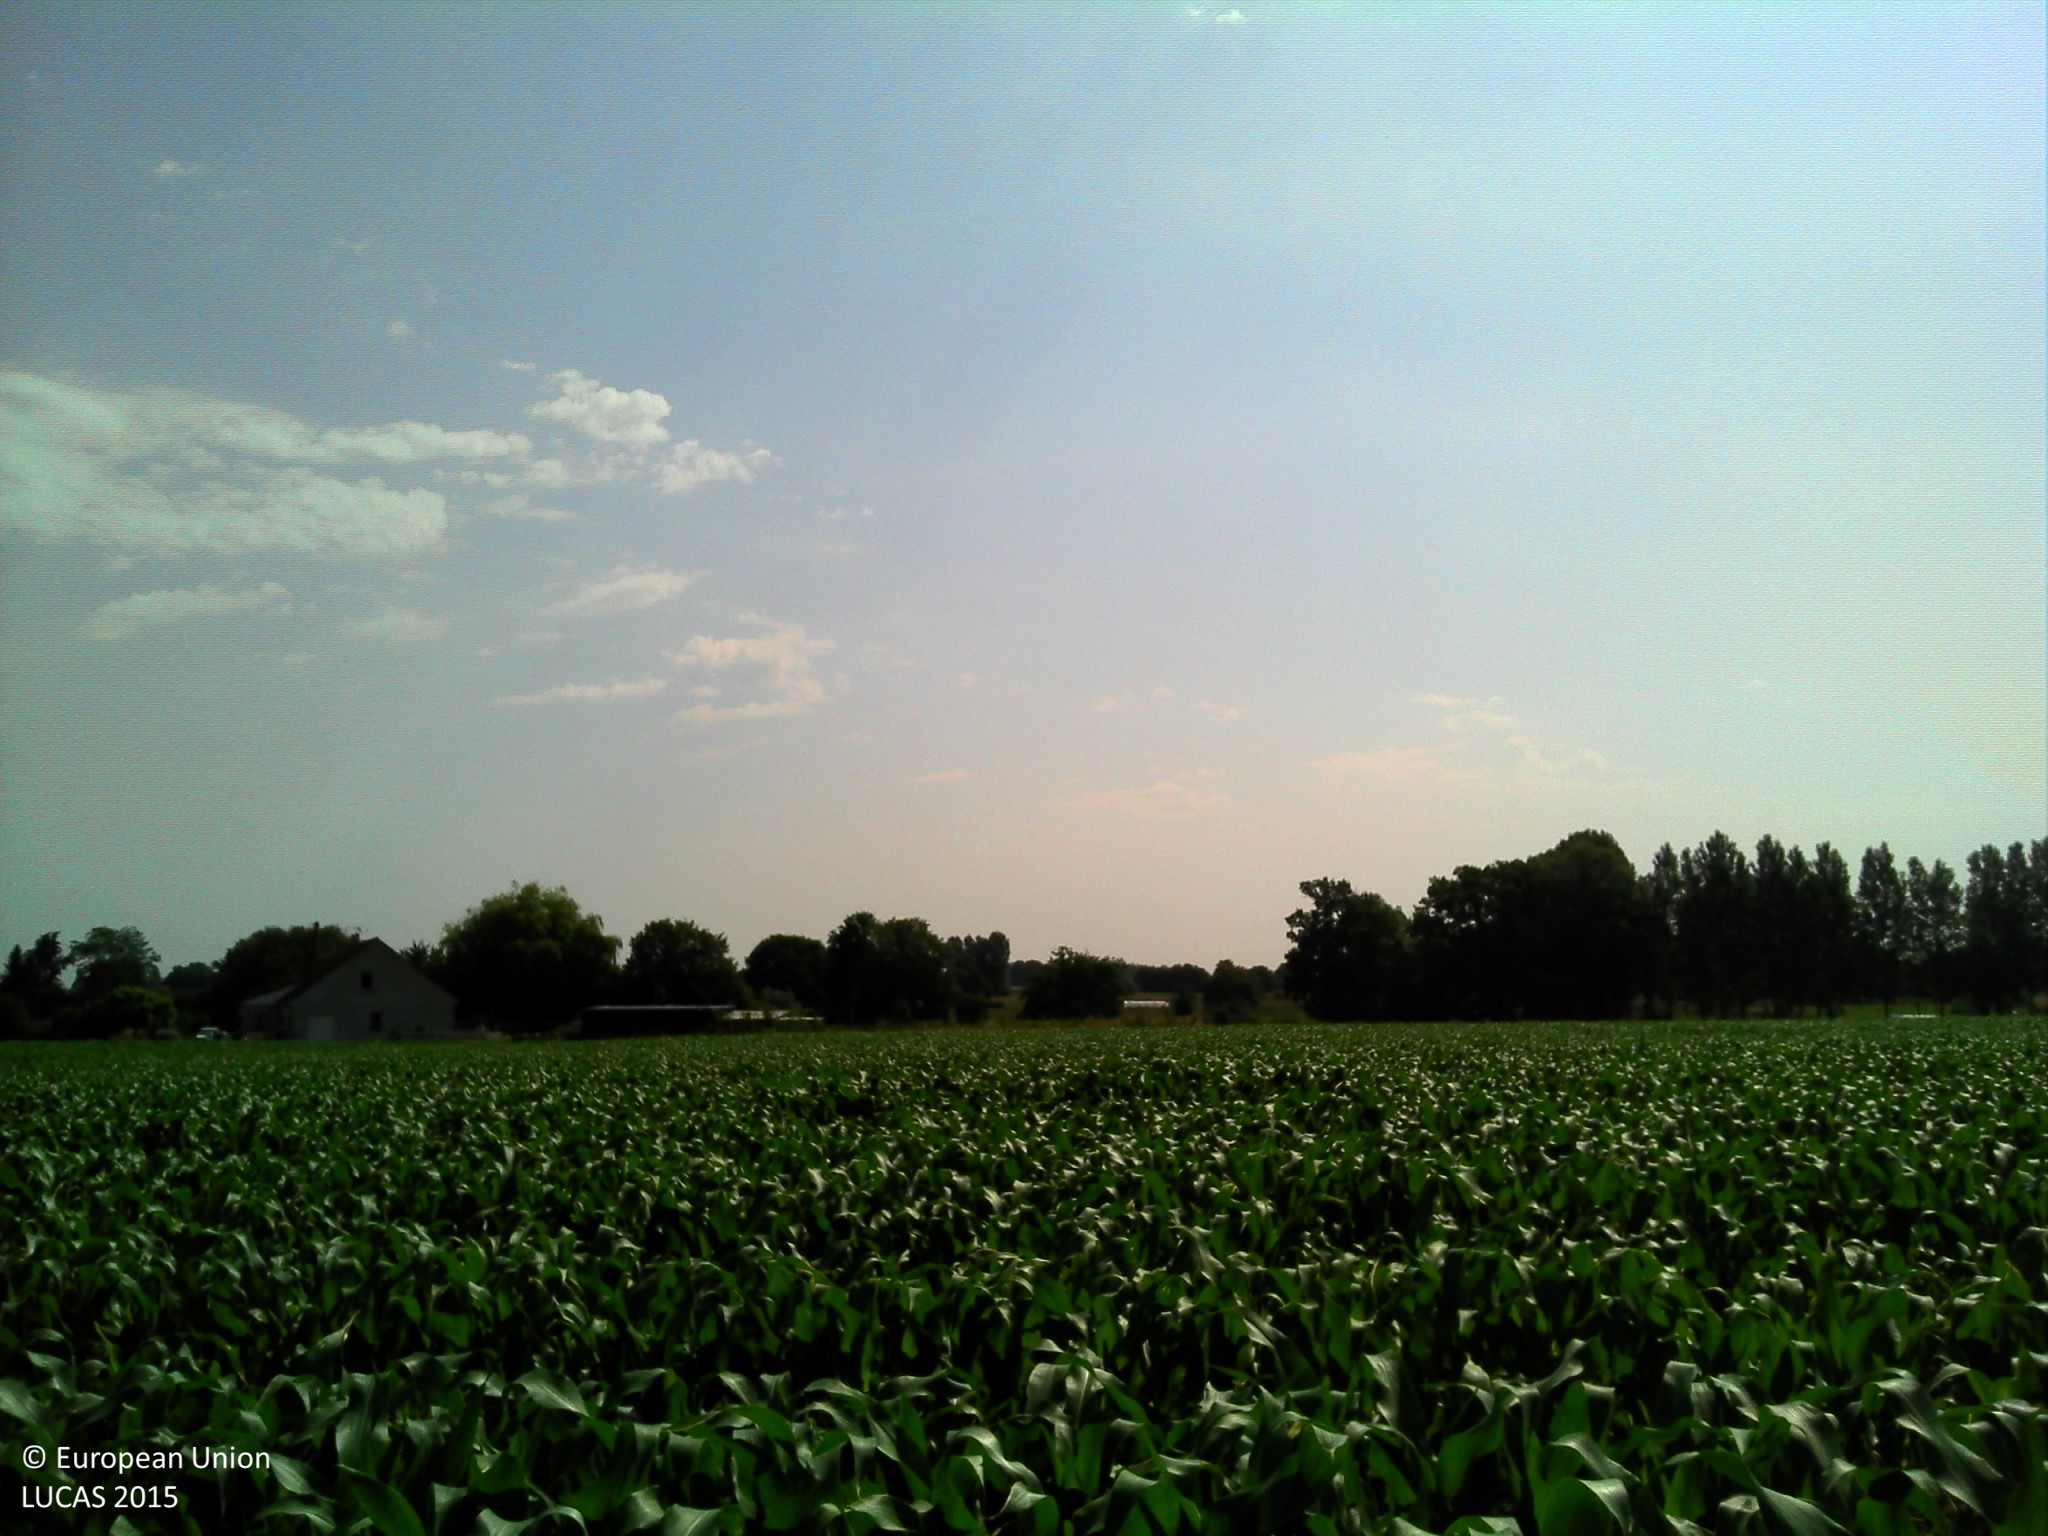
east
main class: Cropland
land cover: Maize
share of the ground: > 75 %
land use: Agriculture (excluding fallow land and kitchen gardens)
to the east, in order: Maize; Ditches and canals; Maize; Broadleaved woodland; Lines of trees
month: July
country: FR
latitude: 47.8231
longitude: 0.2107
